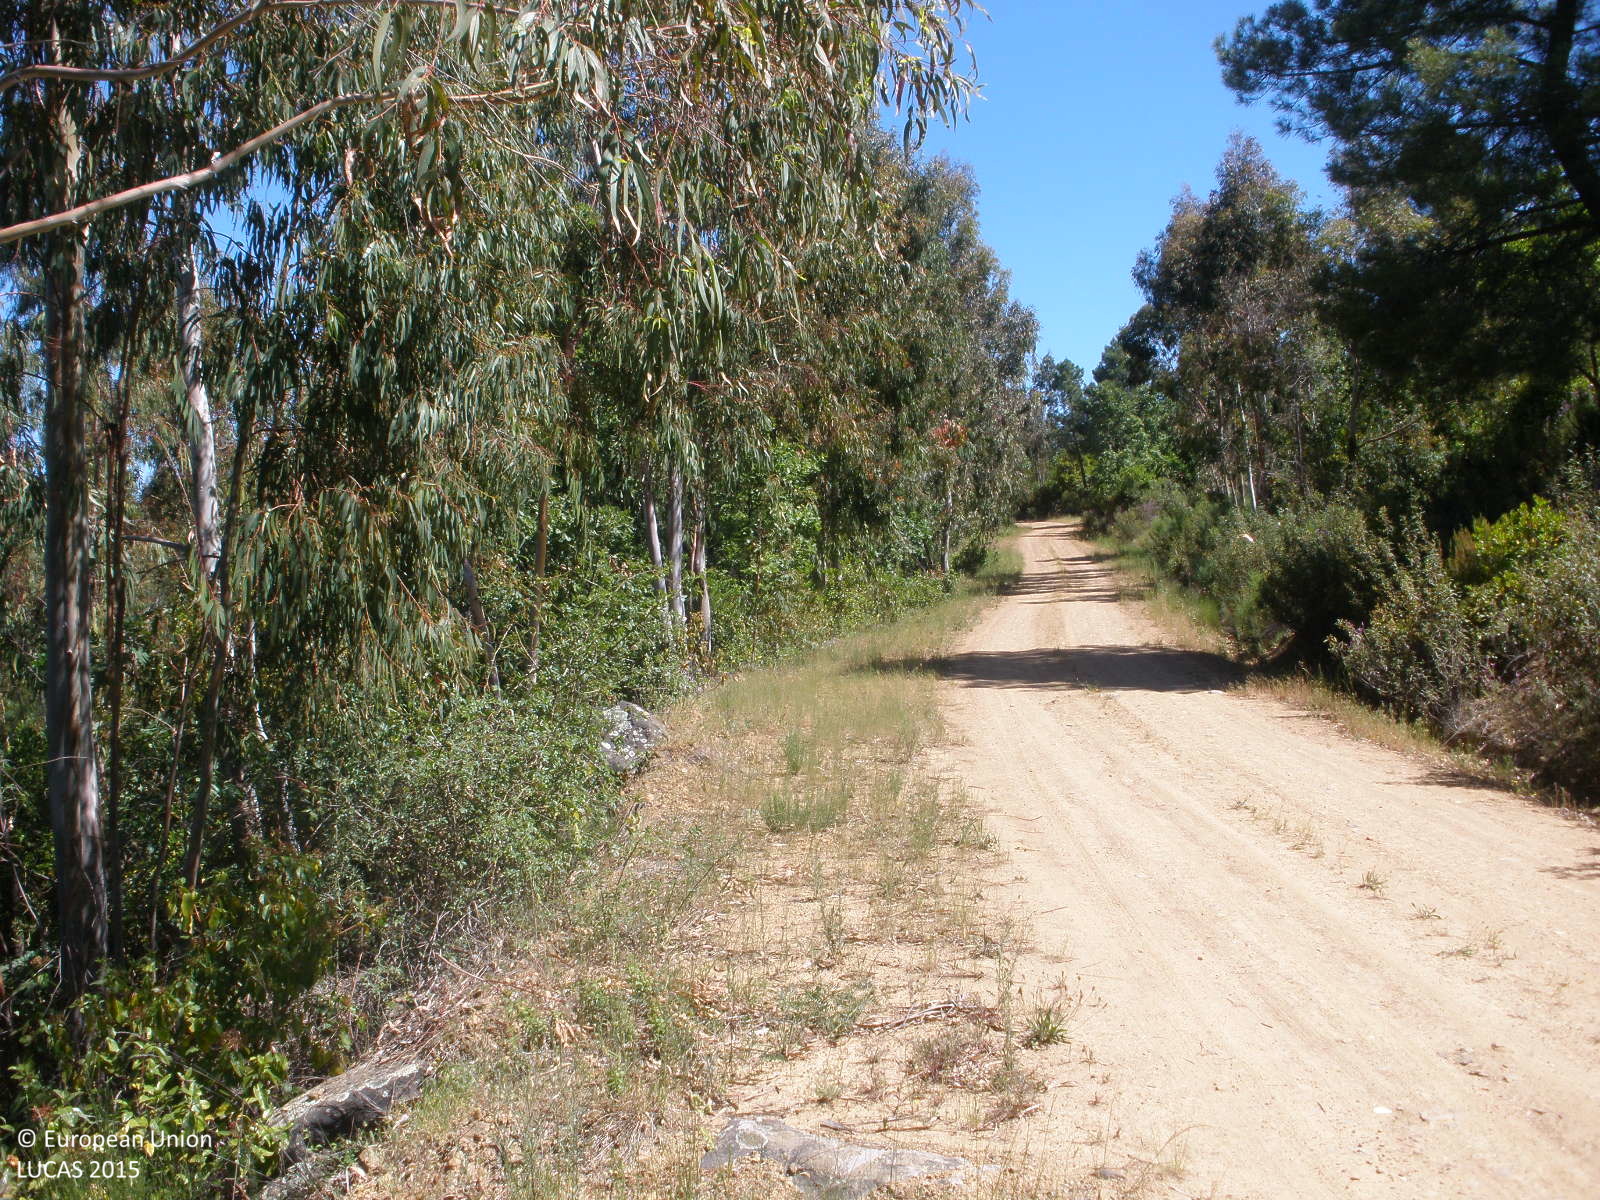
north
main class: Woodland
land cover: Broadleaved woodland
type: broadleaved evergreen forest
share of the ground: > 75 %
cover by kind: broadleaved forest trees 70 %, shrubs 30 %
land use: Forestry
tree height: > 5 m
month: May
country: ES
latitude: 40.4812
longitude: -5.9418
